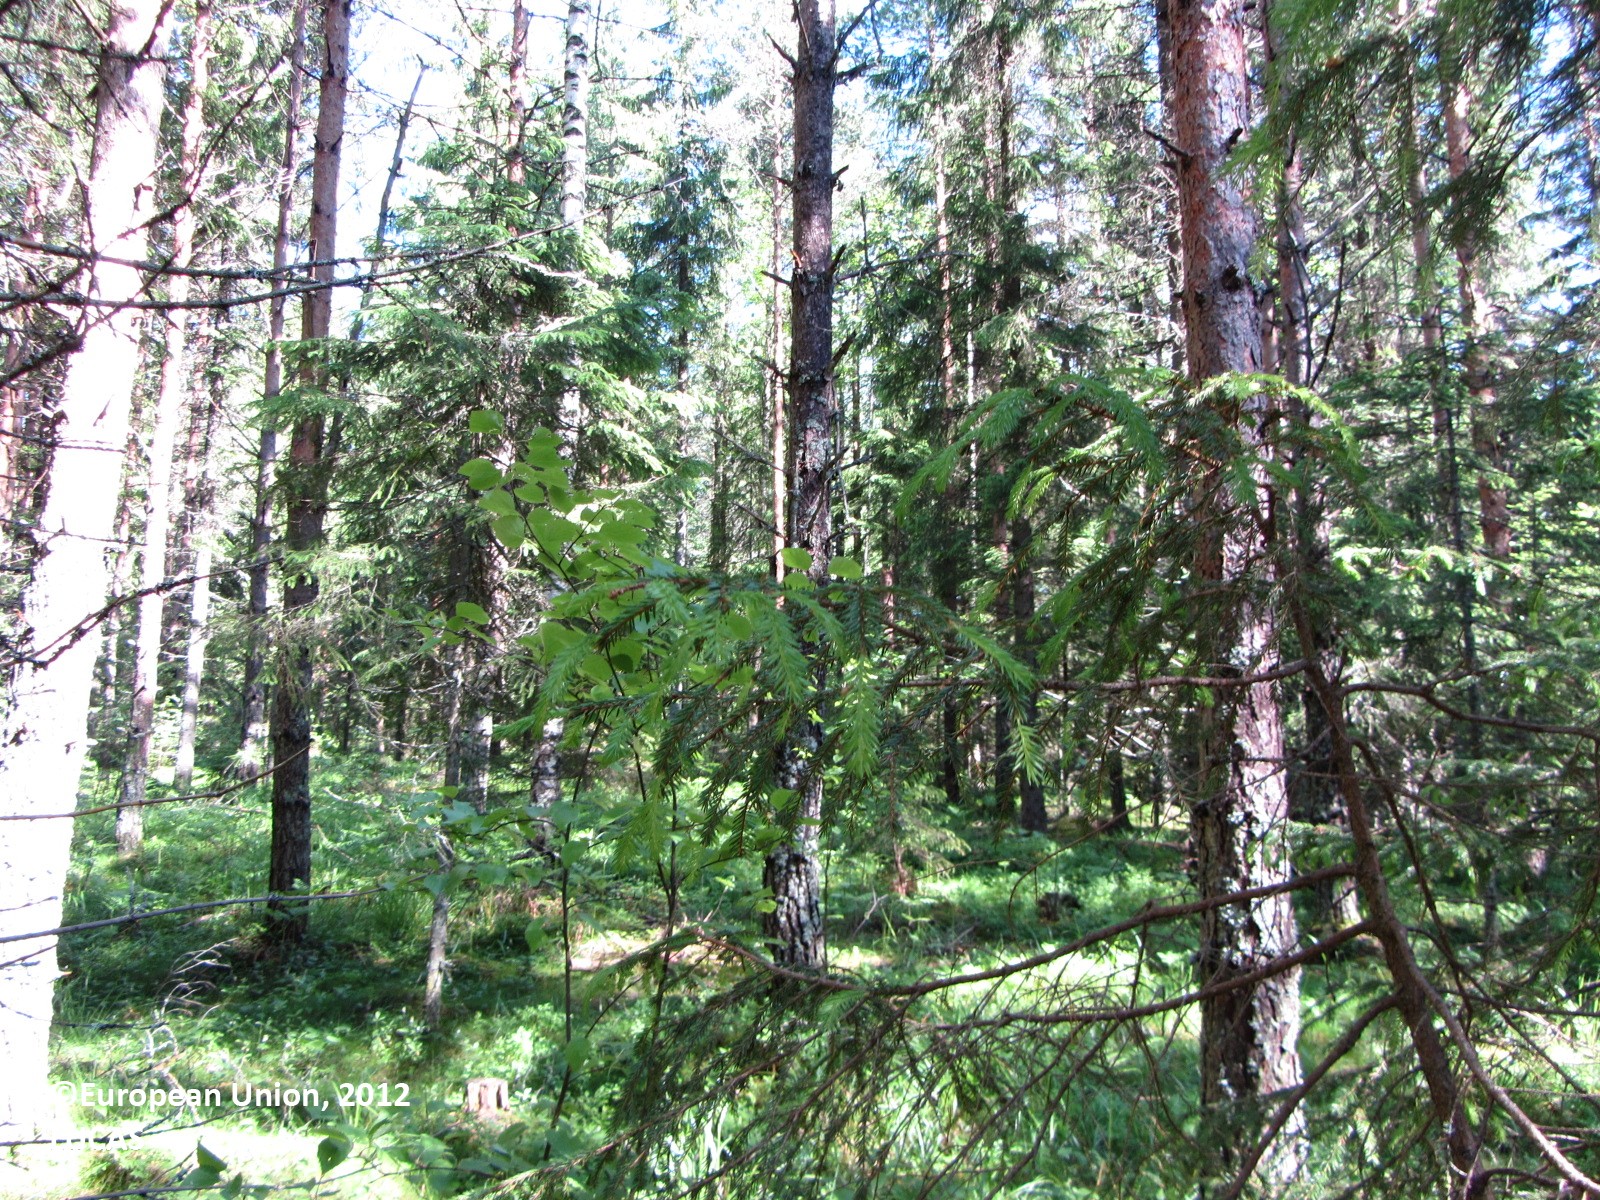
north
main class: Woodland
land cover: Other coniferous woodland
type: boreal forest
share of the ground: 50 - 75 %
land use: Forestry
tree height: > 5 m
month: June
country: FI
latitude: 62.1211
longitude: 25.2735
